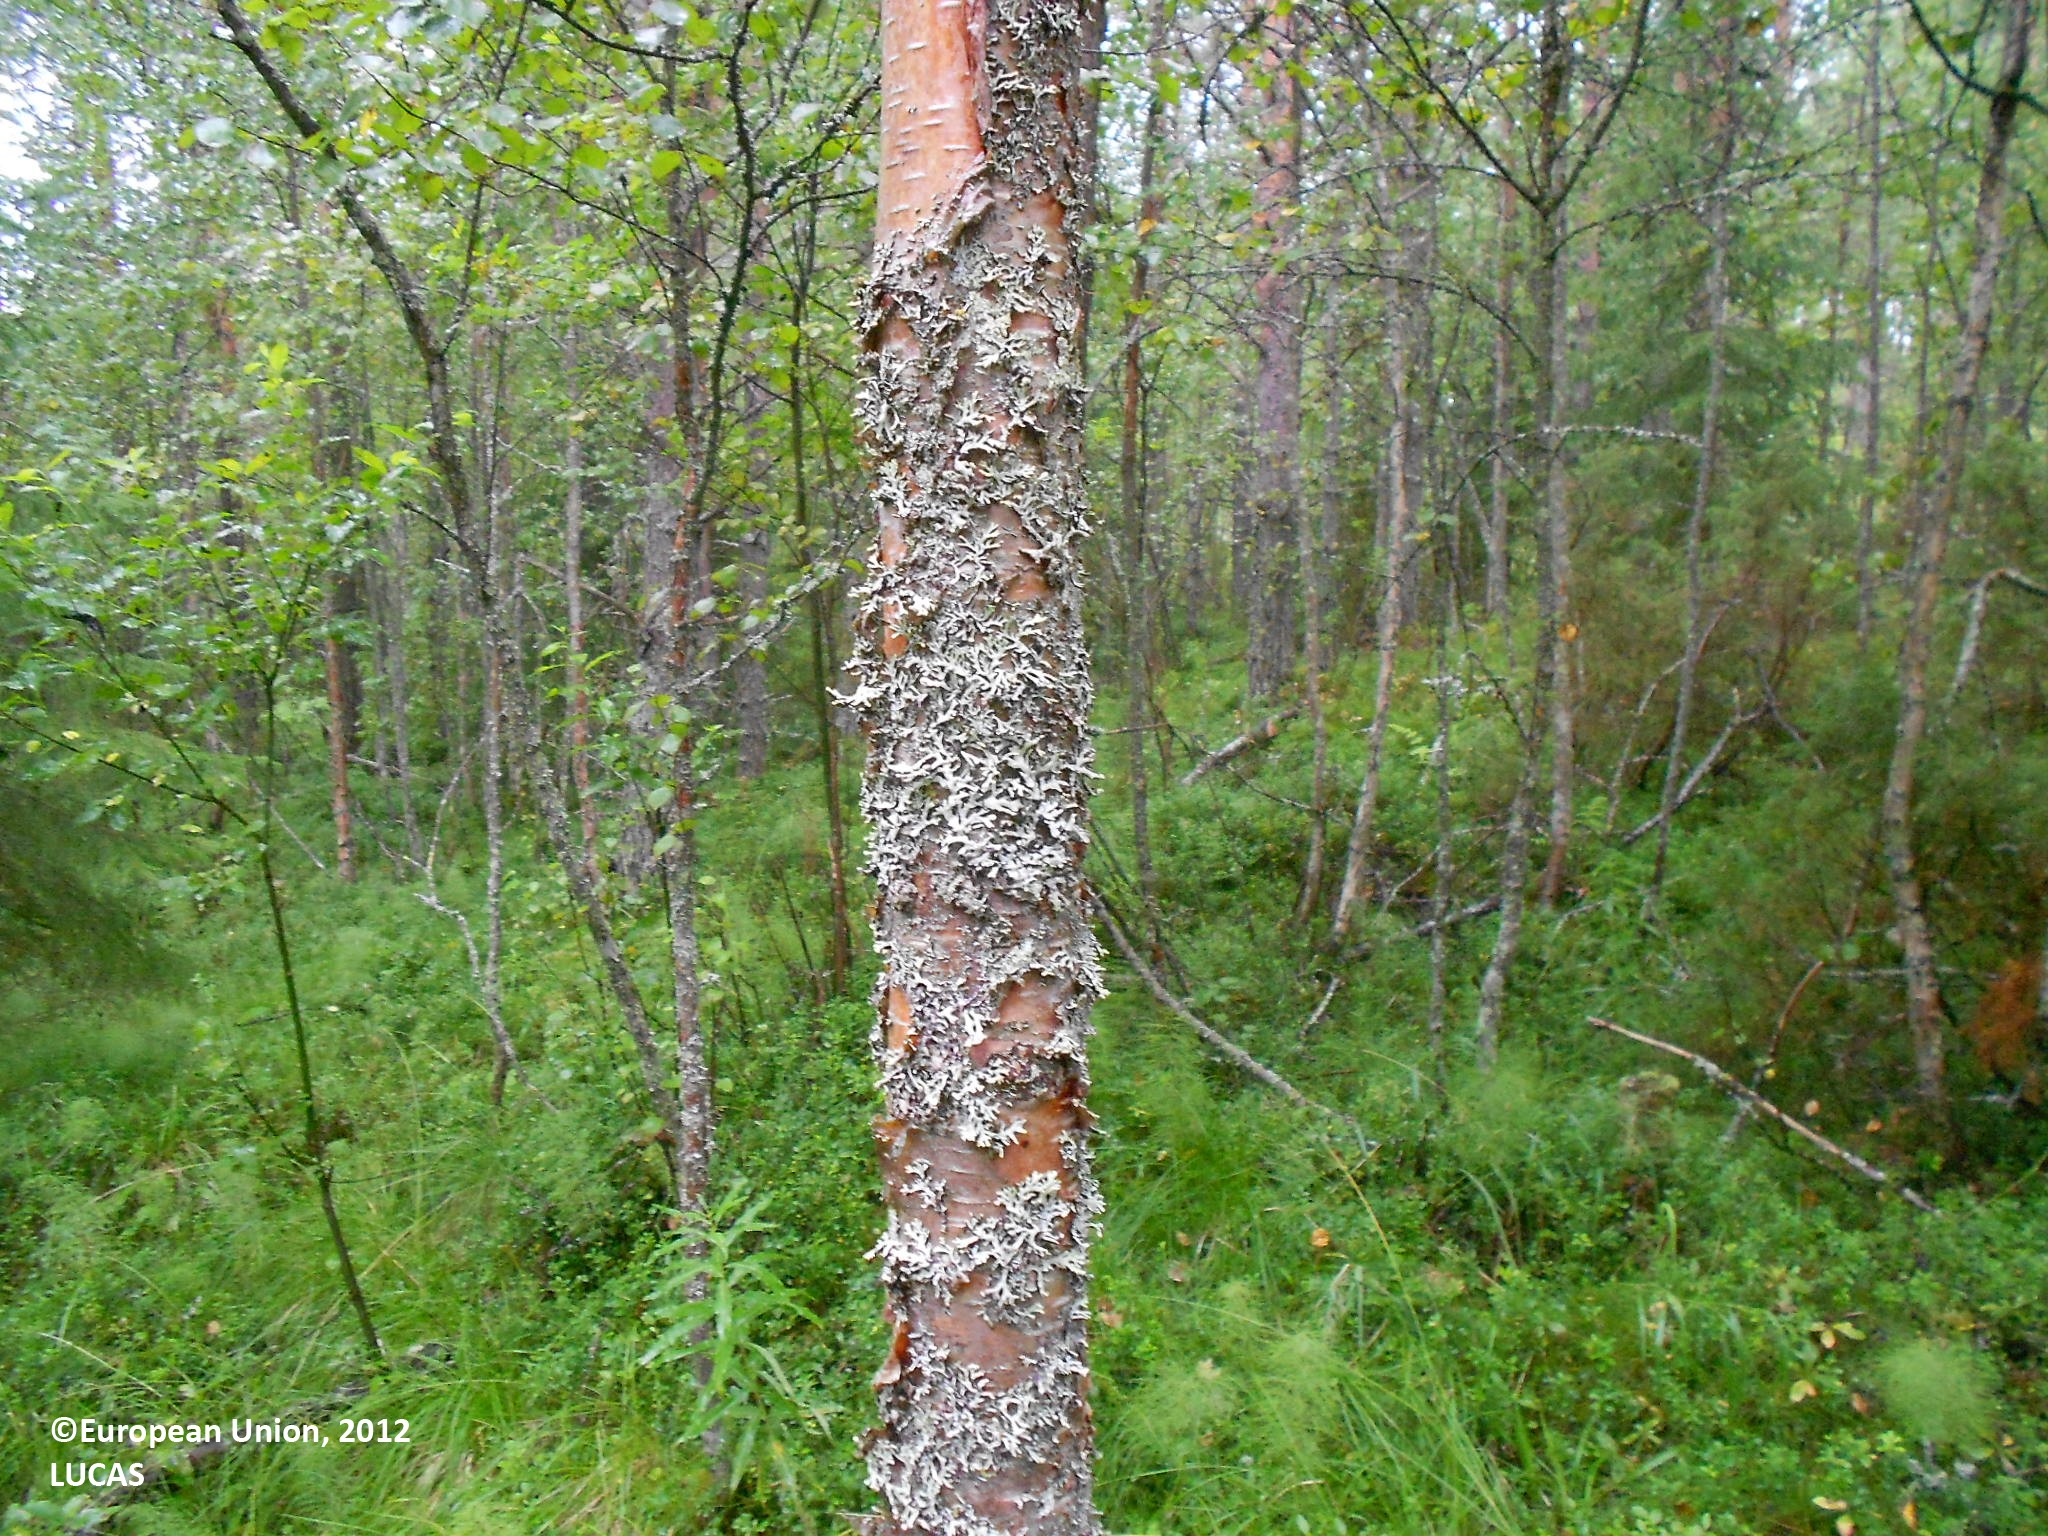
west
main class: Woodland
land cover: Pine dominated mixed woodland
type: boreal forest
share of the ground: 50 - 75 %
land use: Forestry
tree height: > 5 m
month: August
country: FI
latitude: 63.8214
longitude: 28.6162
